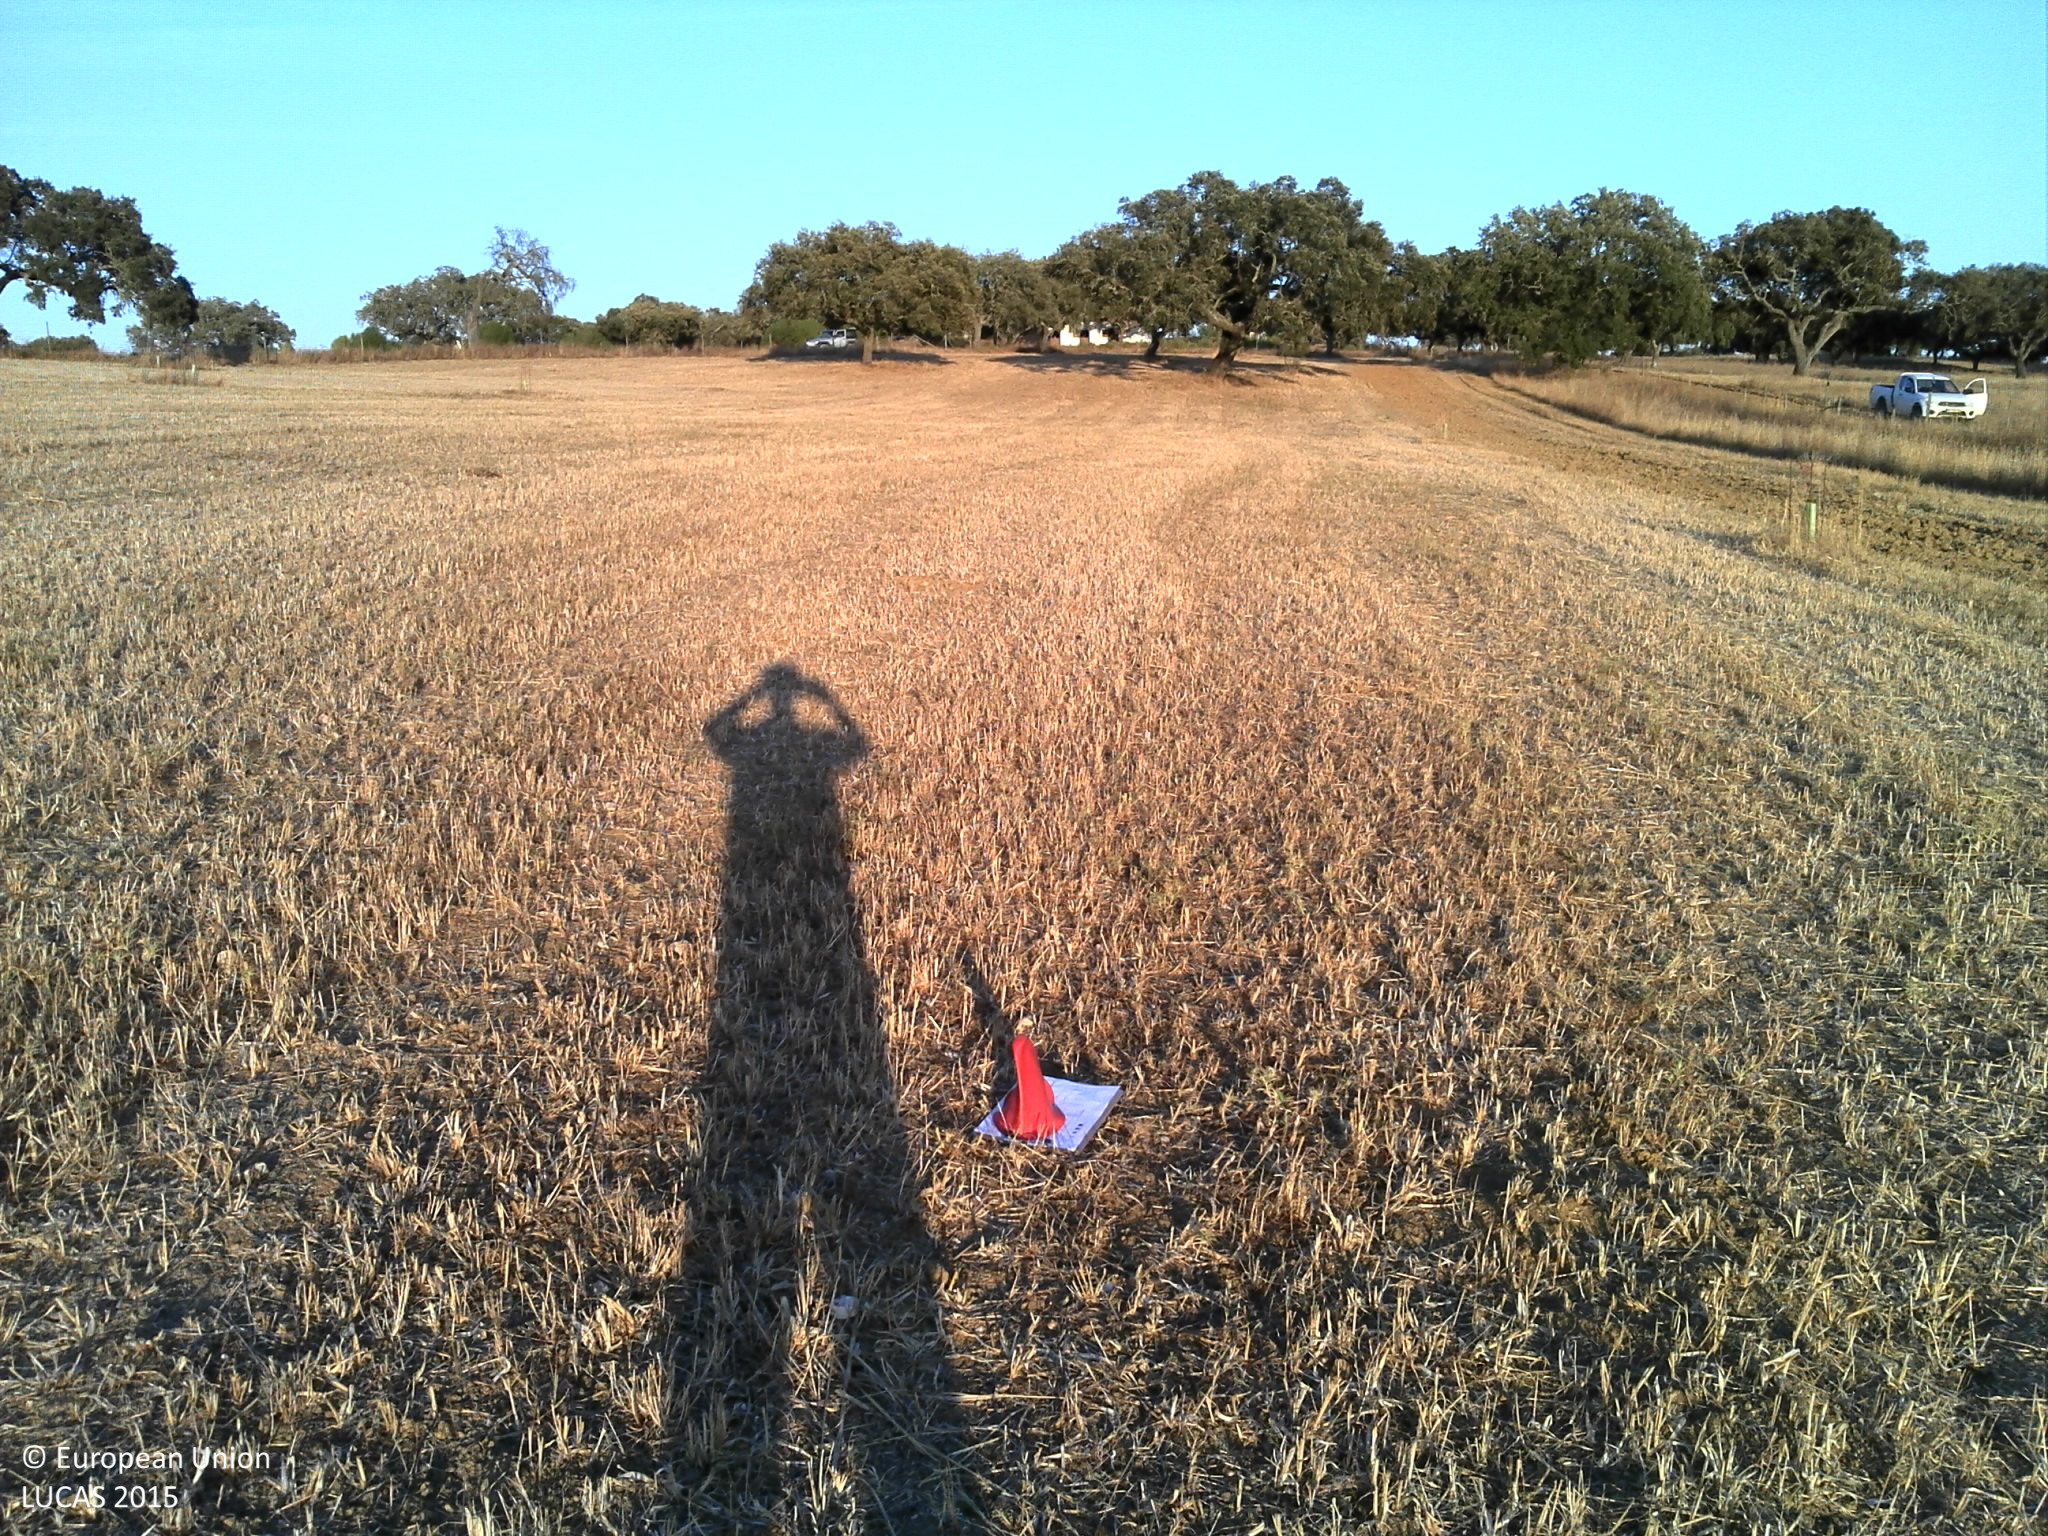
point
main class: Grassland
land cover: Spontaneously vegetated surfaces
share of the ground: 10 - 25 %
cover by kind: consolidated bare surface 85 %, herbaceous plants 15 %
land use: Agriculture (excluding fallow land and kitchen gardens)
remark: Harvested field
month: July
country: PT
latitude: 37.7266
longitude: -8.2411
